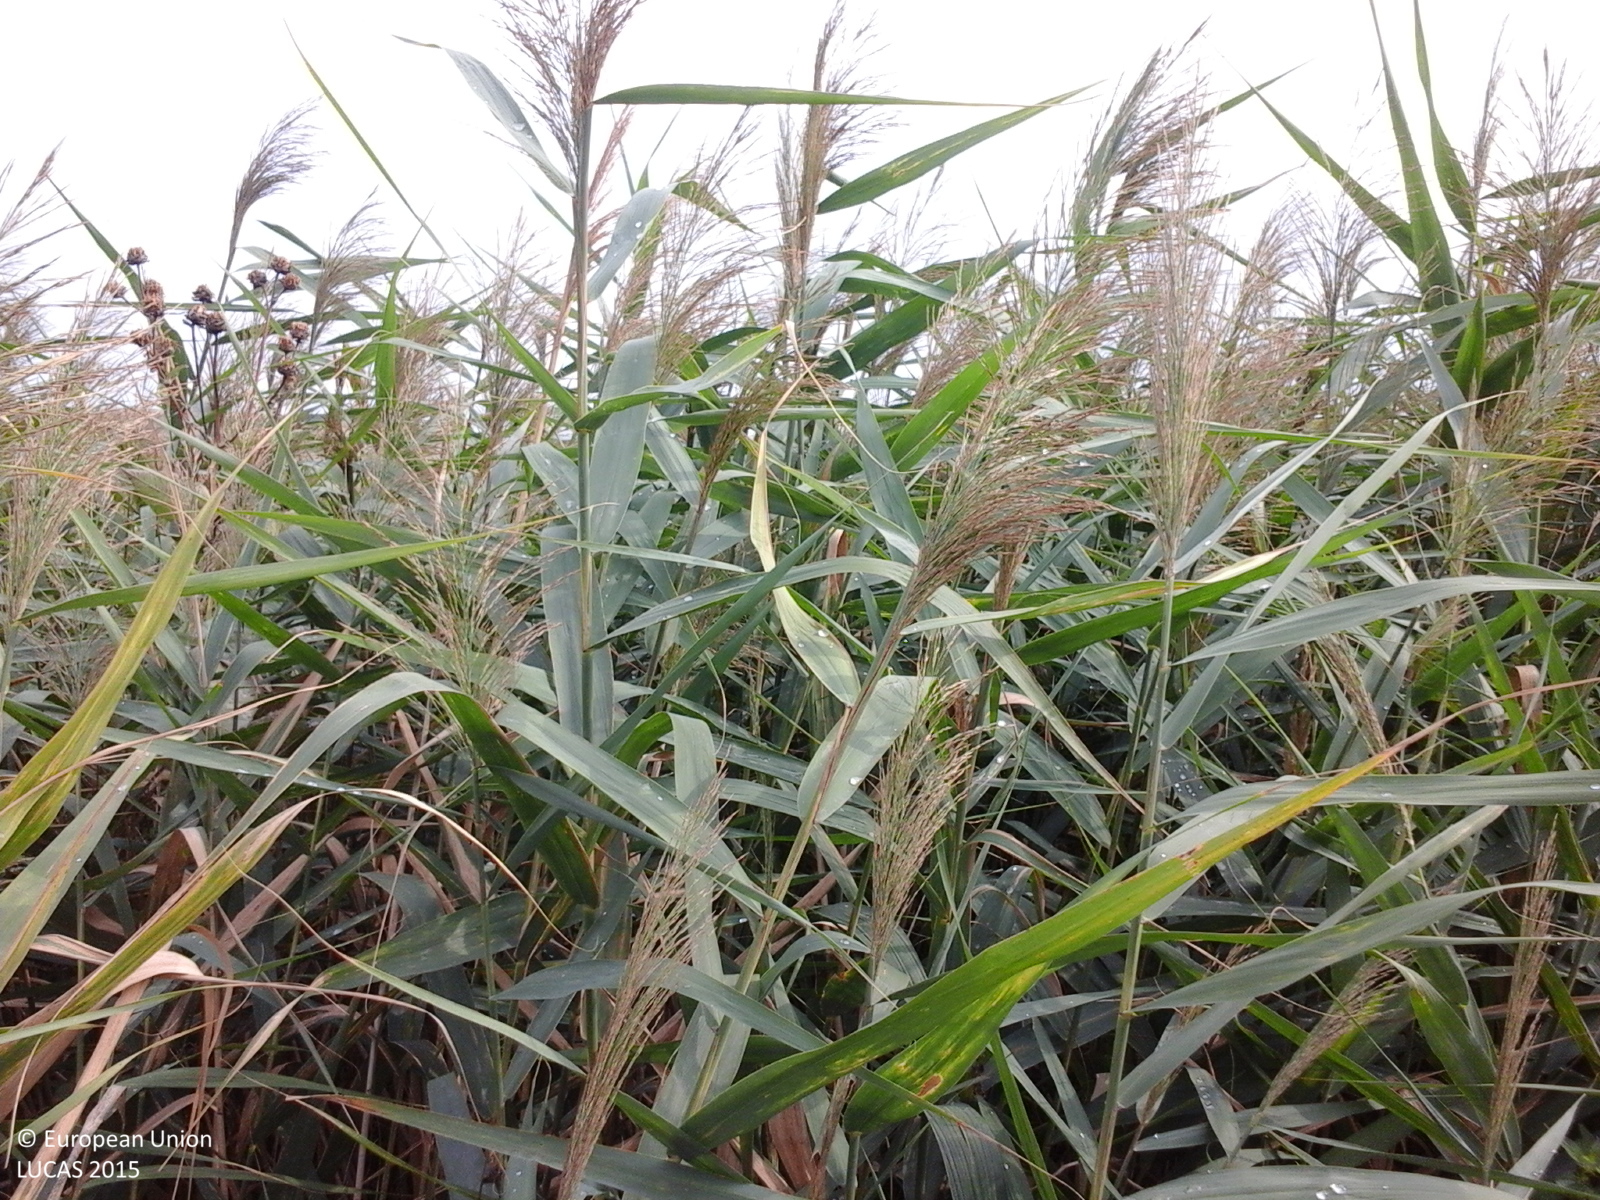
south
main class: Grassland
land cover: Spontaneously vegetated surfaces
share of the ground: > 75 %
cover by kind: herbaceous plants 100 %
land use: Semi-natural and natural areas not in use
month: August
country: RO
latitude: 45.8688
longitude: 21.3820
